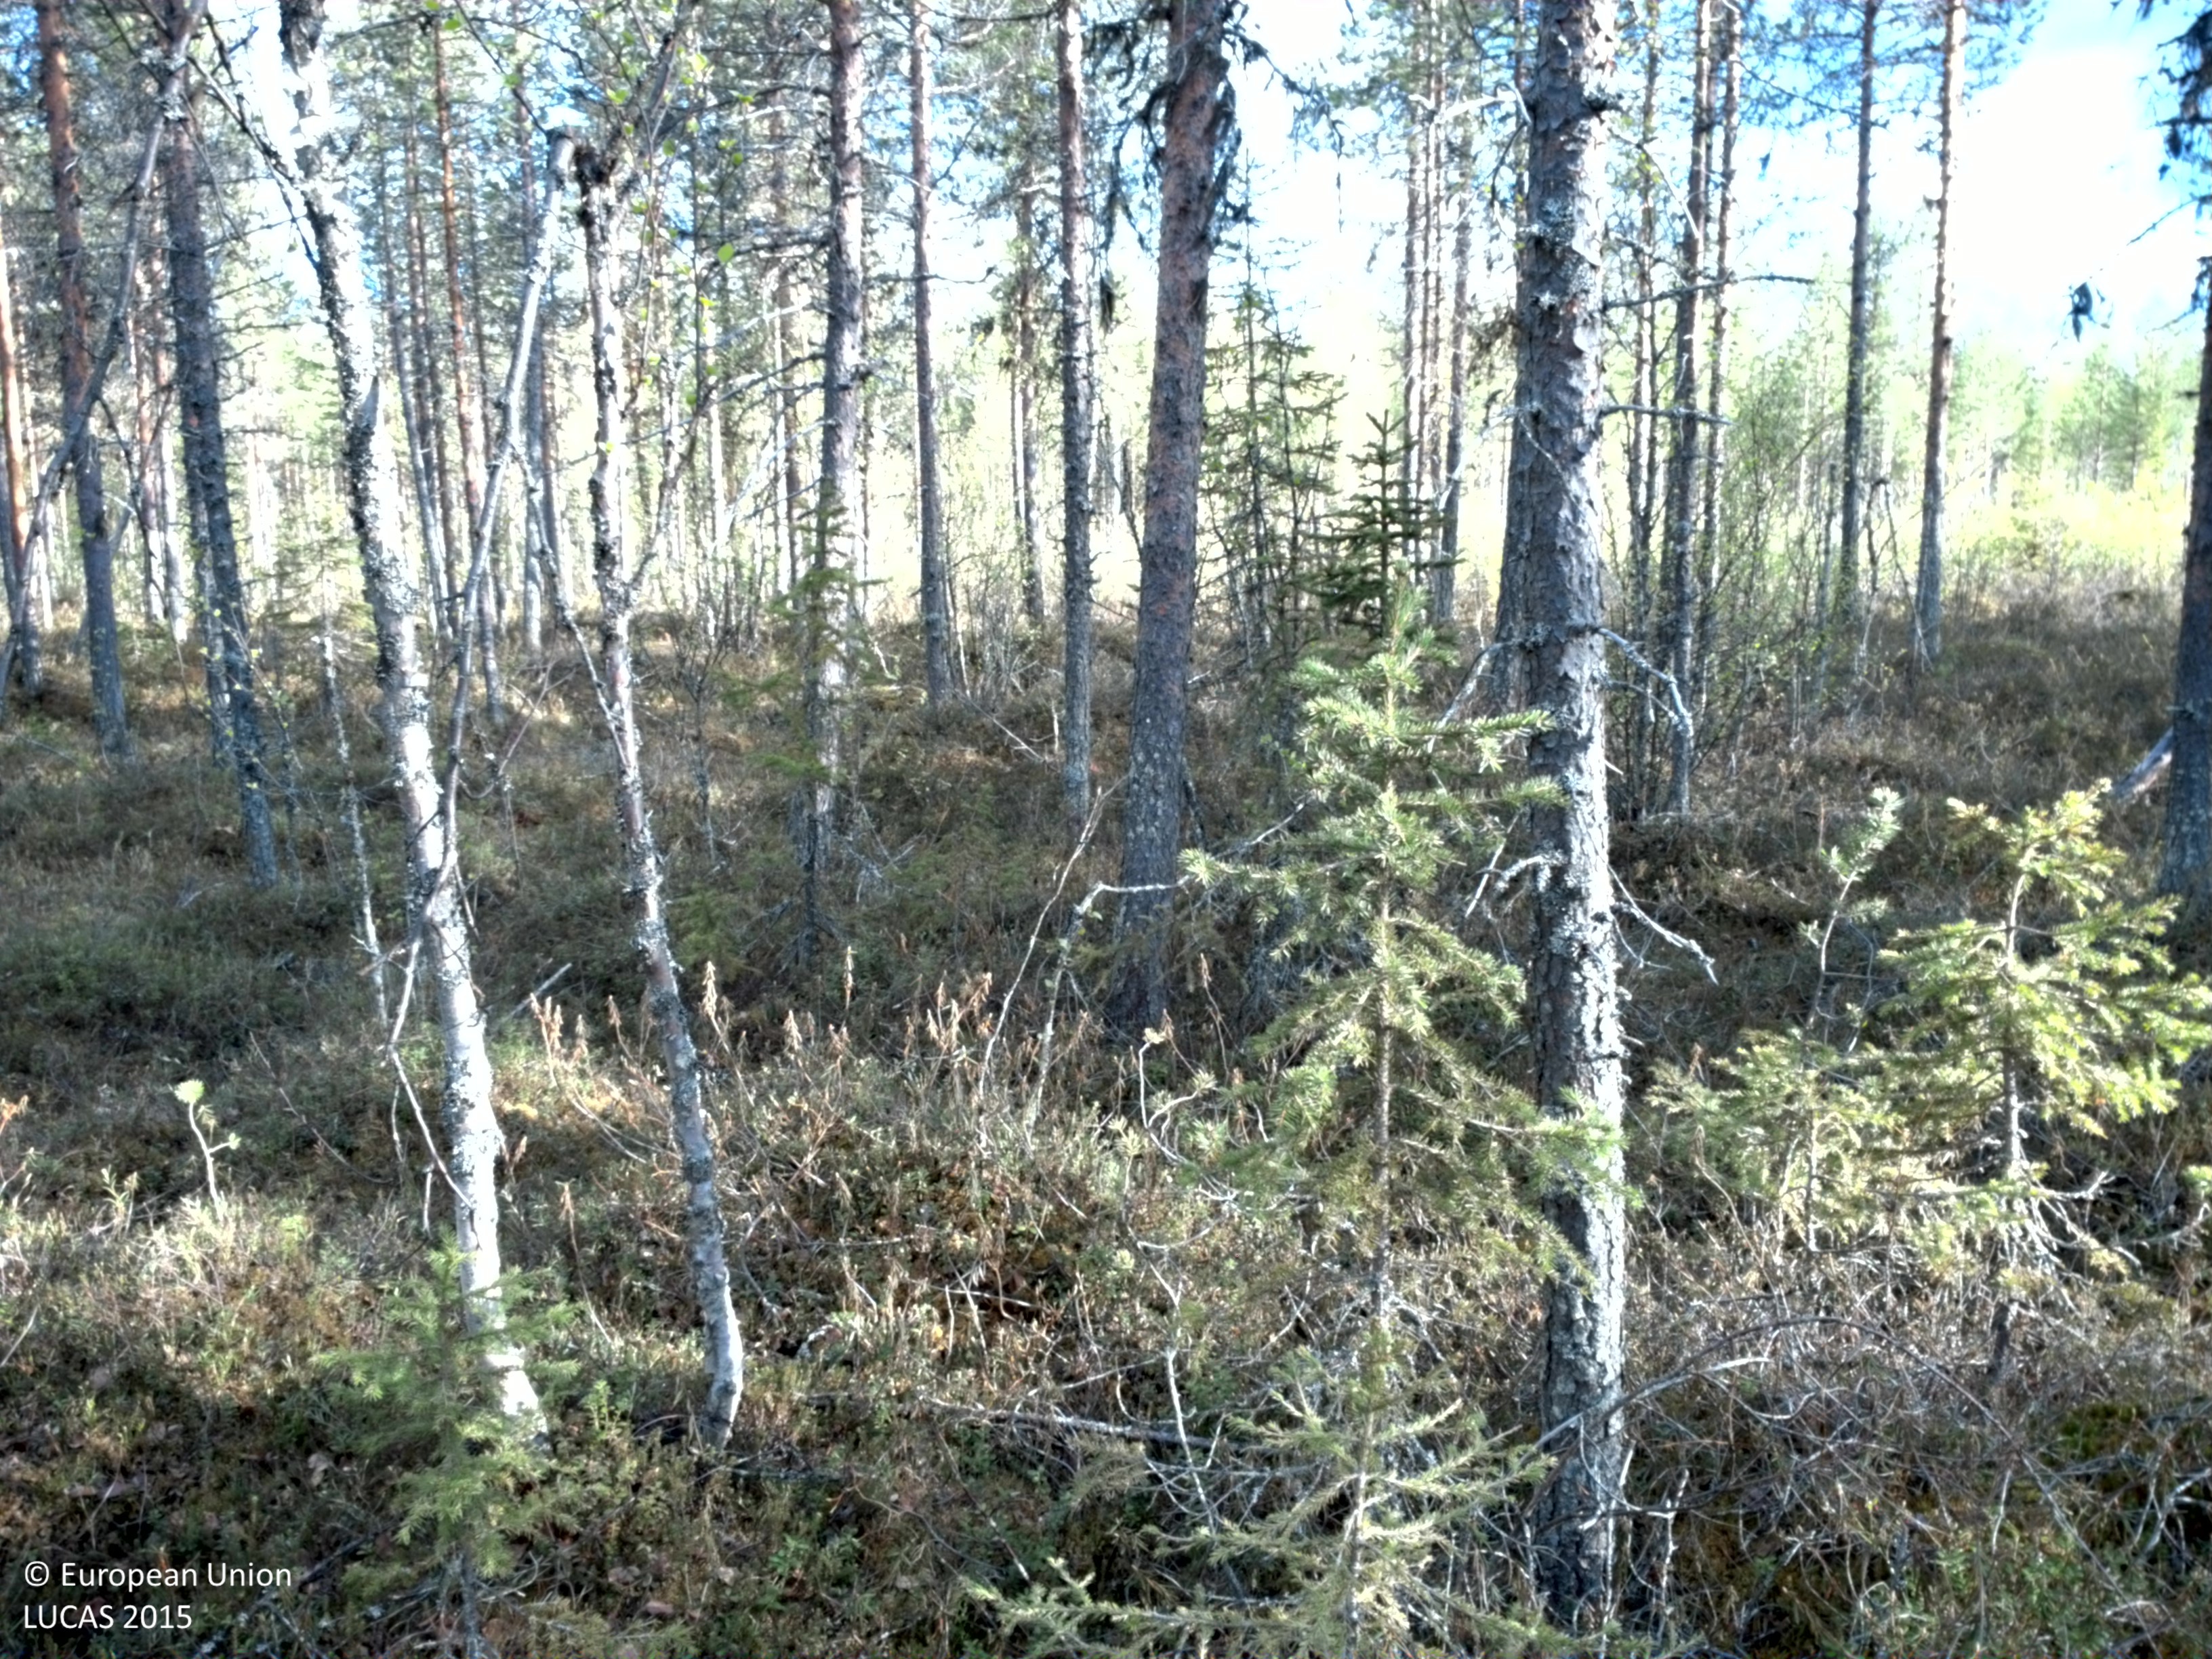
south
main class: Woodland
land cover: Pine dominated coniferous woodland
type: boreal forest
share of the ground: 50 - 75 %
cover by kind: coniferous forest trees 55 %, shrubs 40 %, broadleaved forest trees 5 %
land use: Forestry
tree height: > 5 m
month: June
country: SE
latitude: 66.4757
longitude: 22.9318
